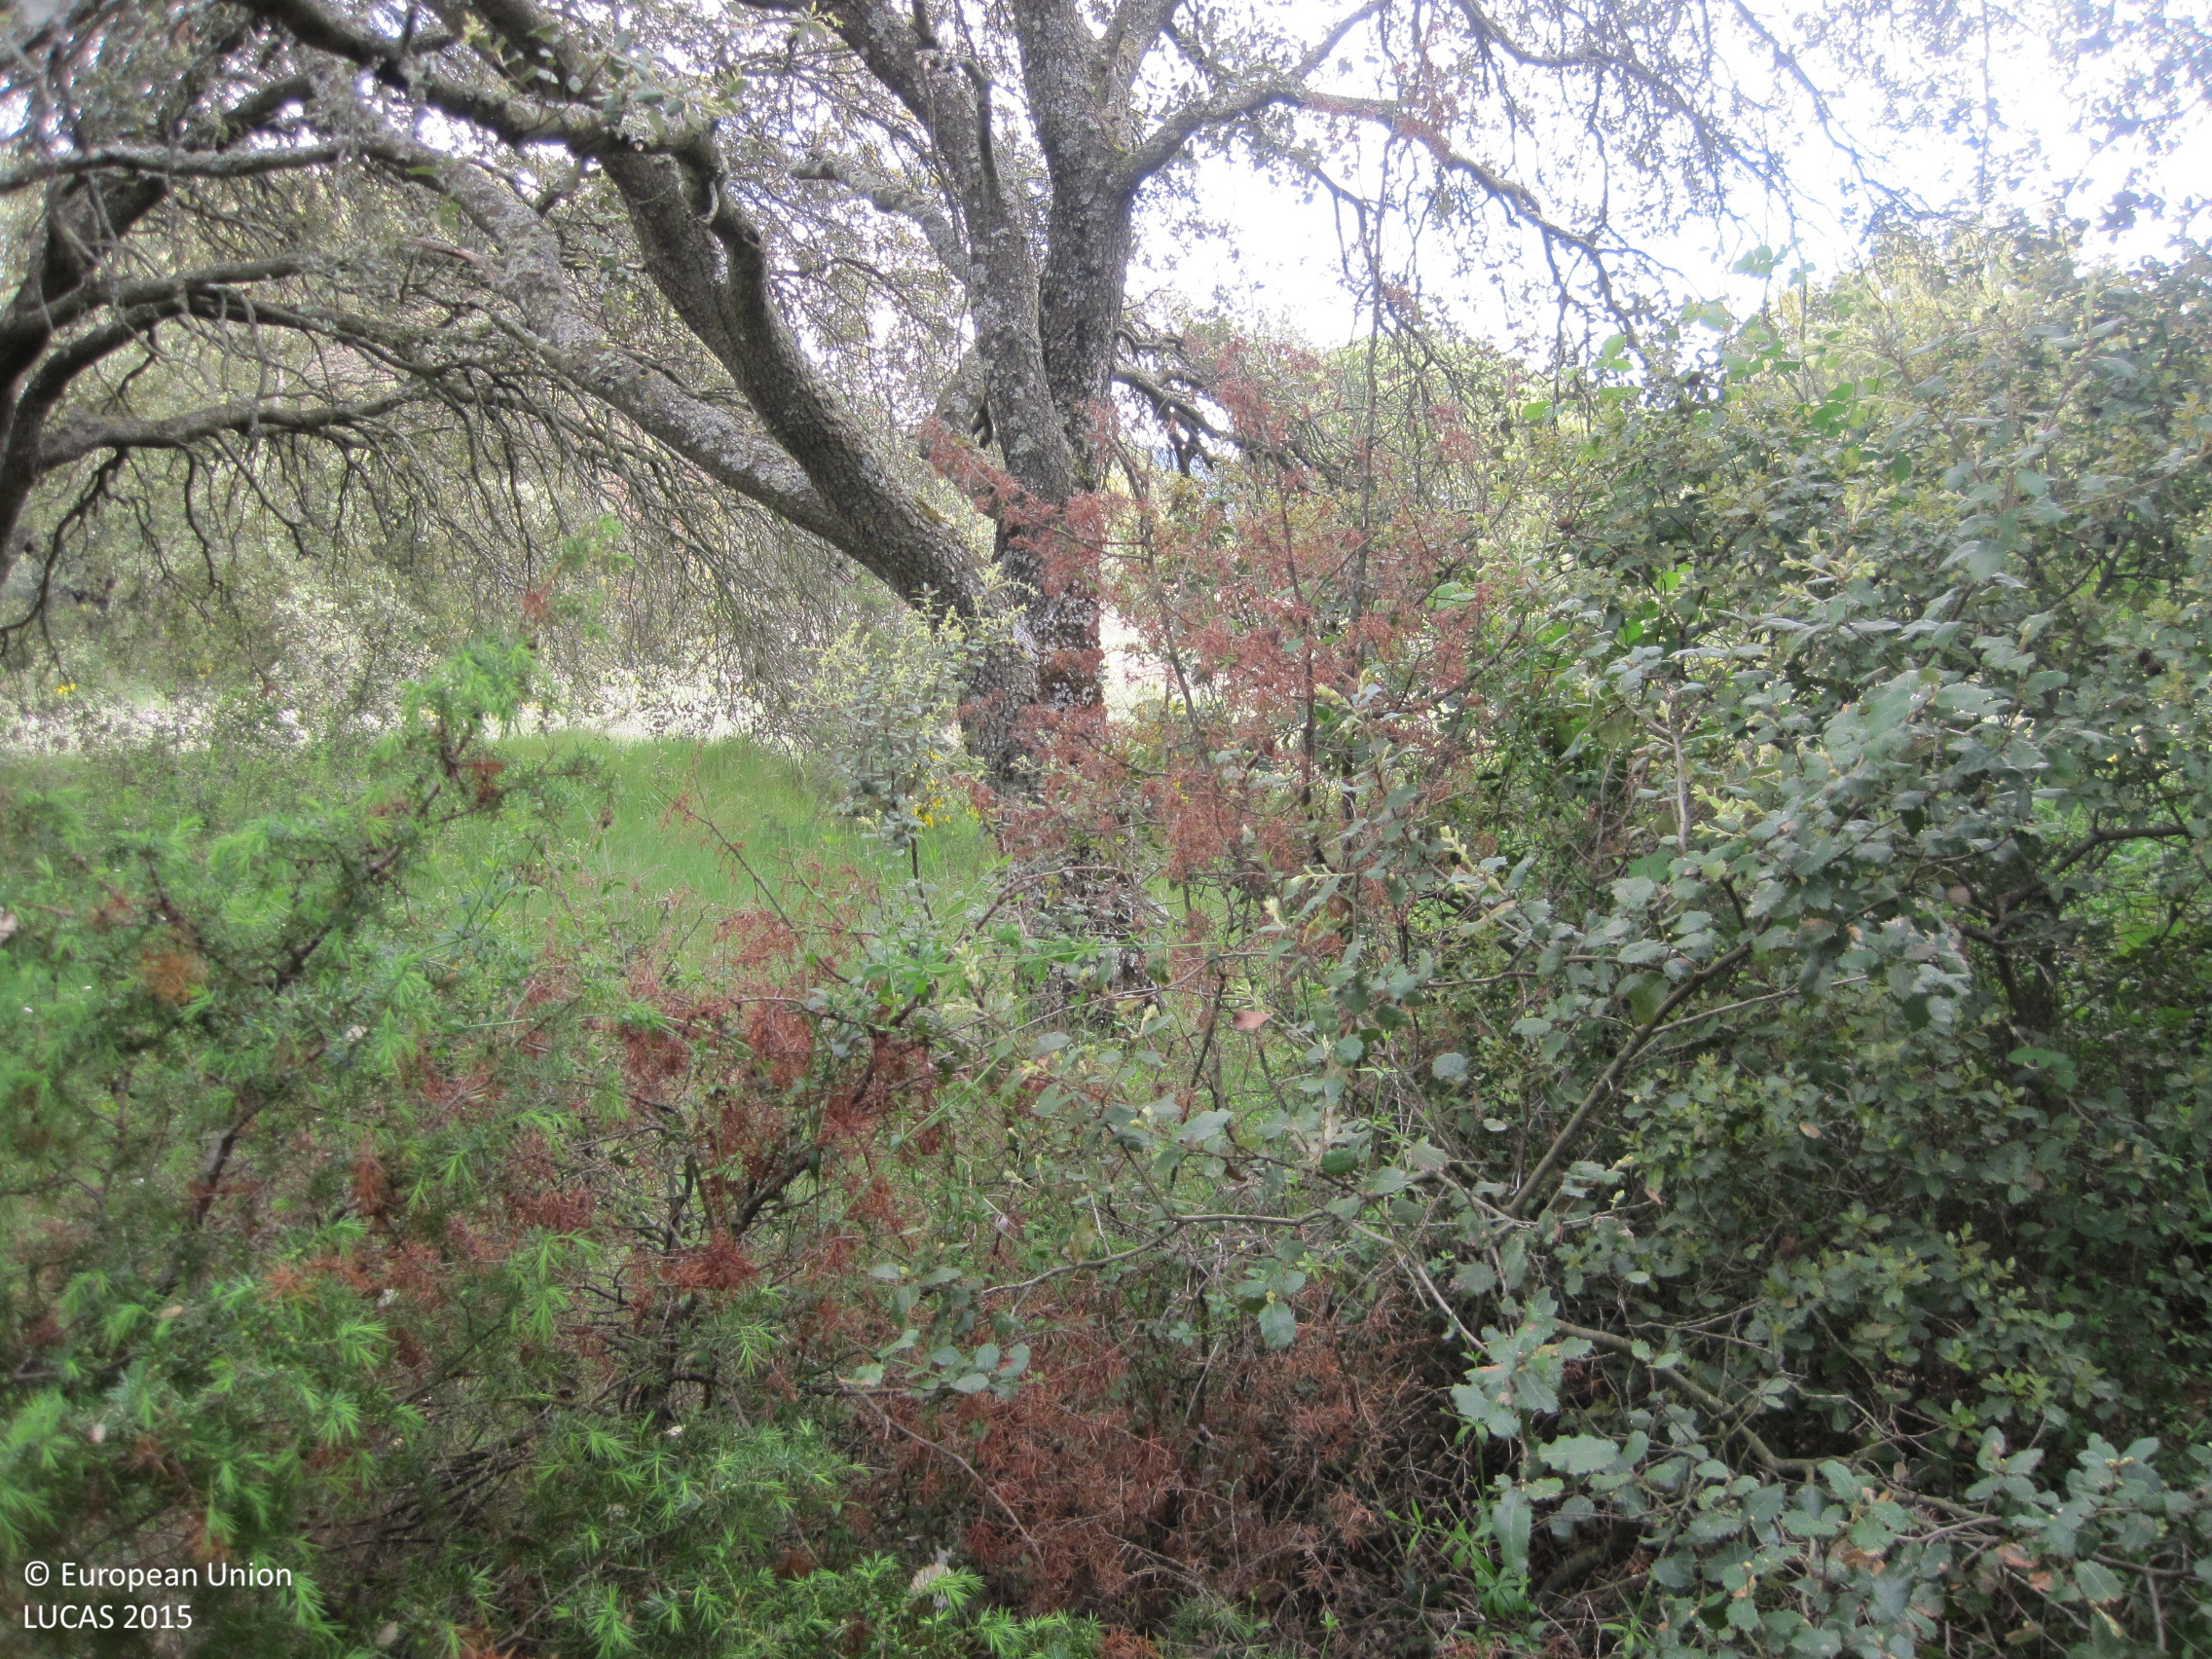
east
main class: Woodland
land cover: Broadleaved woodland
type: acidophilous oak and oak-birch forest
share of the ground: 50 - 75 %
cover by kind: broadleaved forest trees 50 %, herbaceous plants 35 %, shrubs 10 %, unconsolidated bare surface 5 %
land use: Semi-natural and natural areas not in use
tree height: > 5 m
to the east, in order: Broadleaved woodland; Shrubland with sparse tree cover; Tracks; Broadleaved woodland
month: May
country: ES
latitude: 42.7151
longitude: -1.7491
